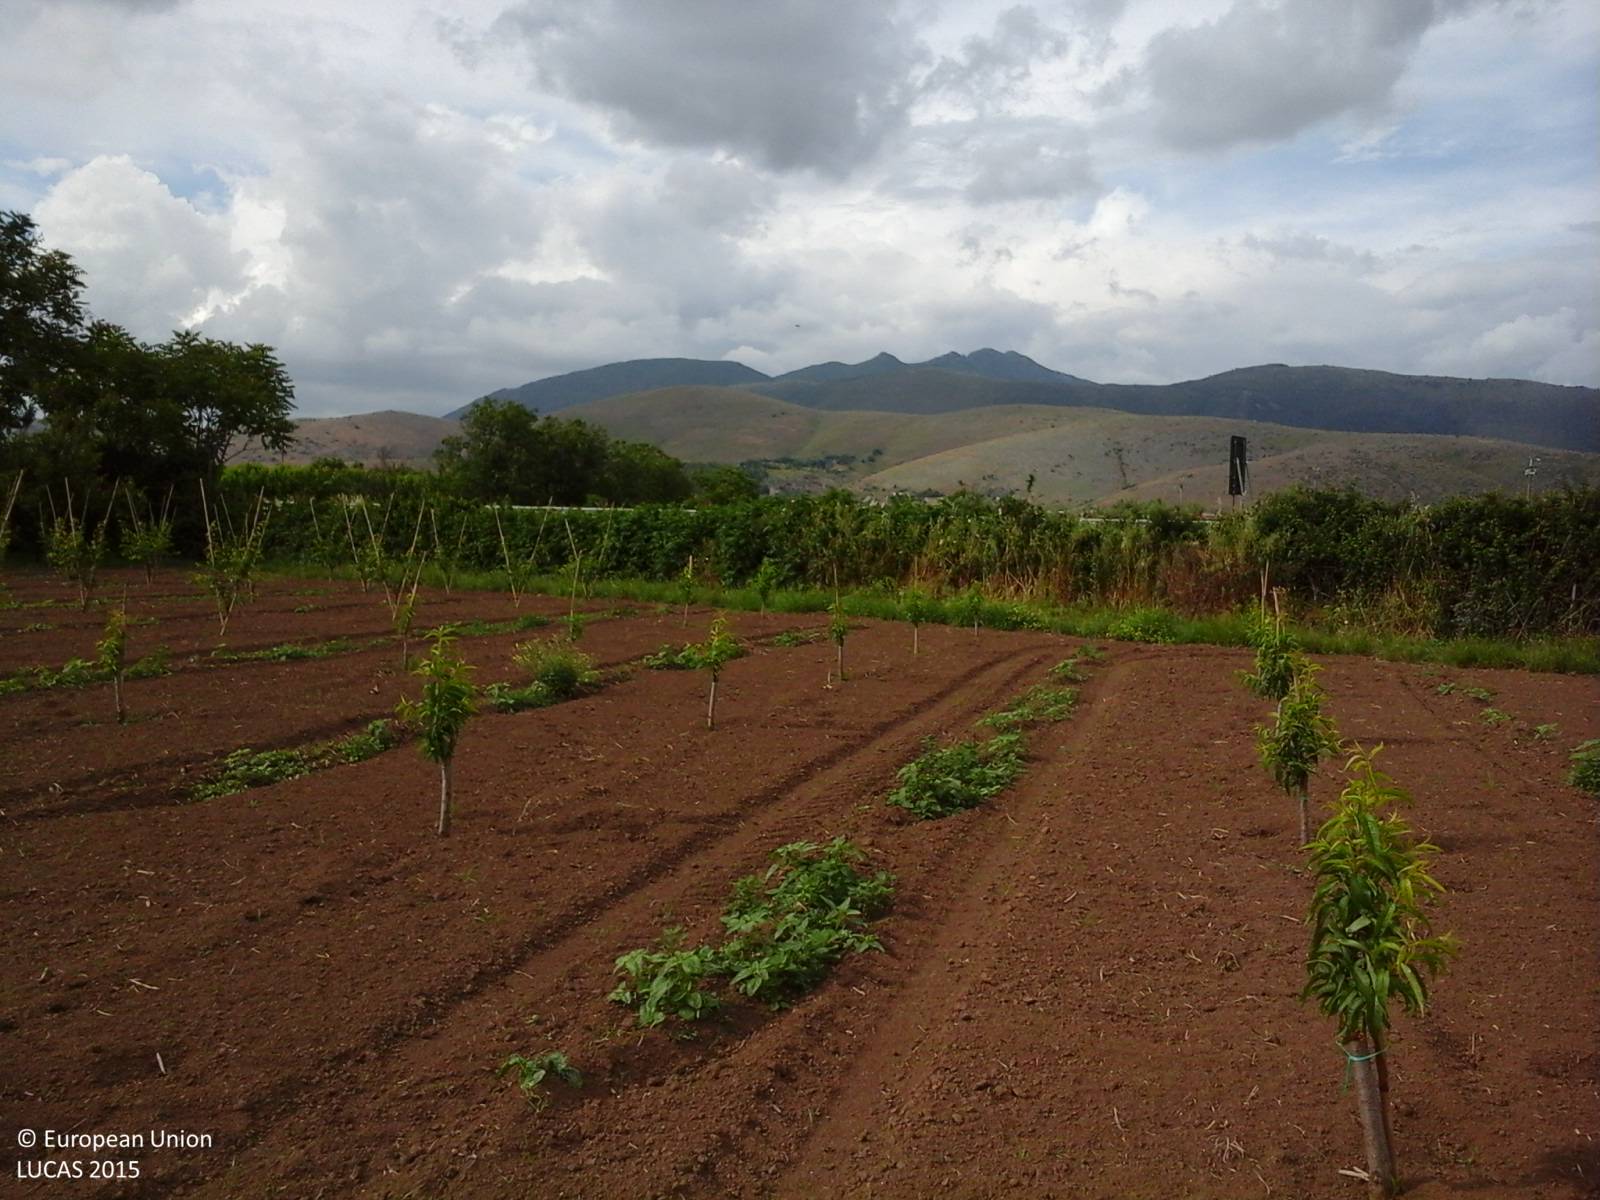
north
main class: Cropland
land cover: Other fruit trees and berries
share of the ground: < 10 %
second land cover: Other bare soil
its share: > 75 %
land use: Agriculture (excluding fallow land and kitchen gardens)
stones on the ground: < 10 %
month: May
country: IT
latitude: 41.1751
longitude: 14.1675
